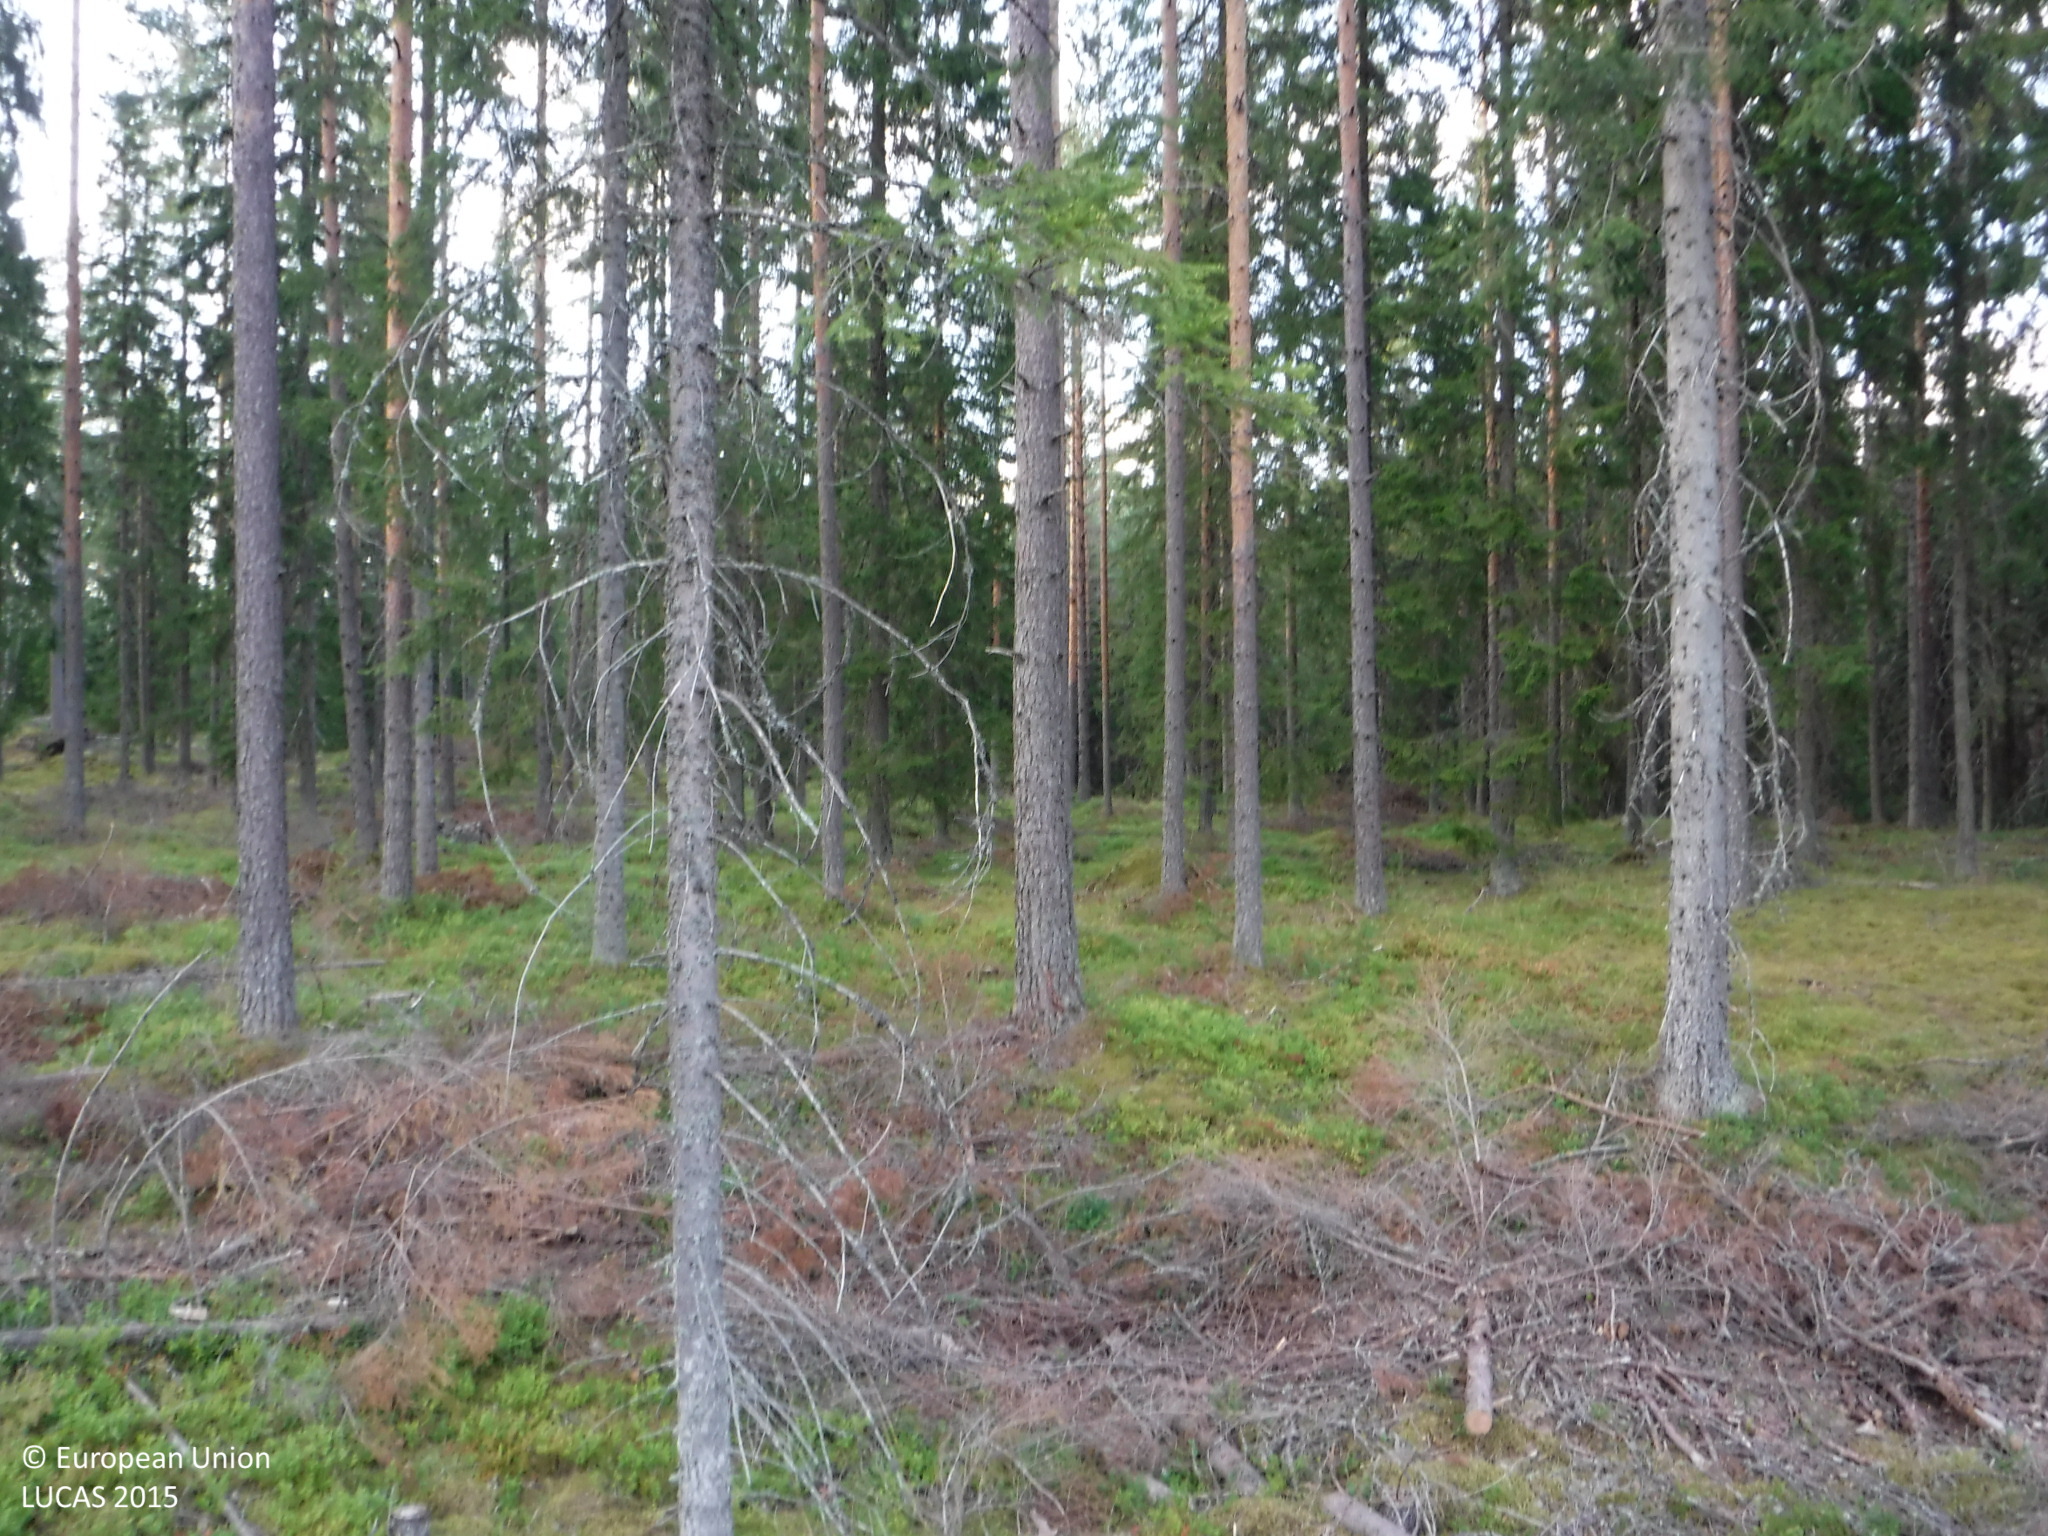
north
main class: Woodland
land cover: Other coniferous woodland
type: boreal forest
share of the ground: 25 - 50 %
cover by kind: coniferous forest trees 50 %, shrubs 30 %, lichens and mosses 20 %
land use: Forestry
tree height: > 5 m
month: August
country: FI
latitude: 61.1610
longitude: 23.0654
